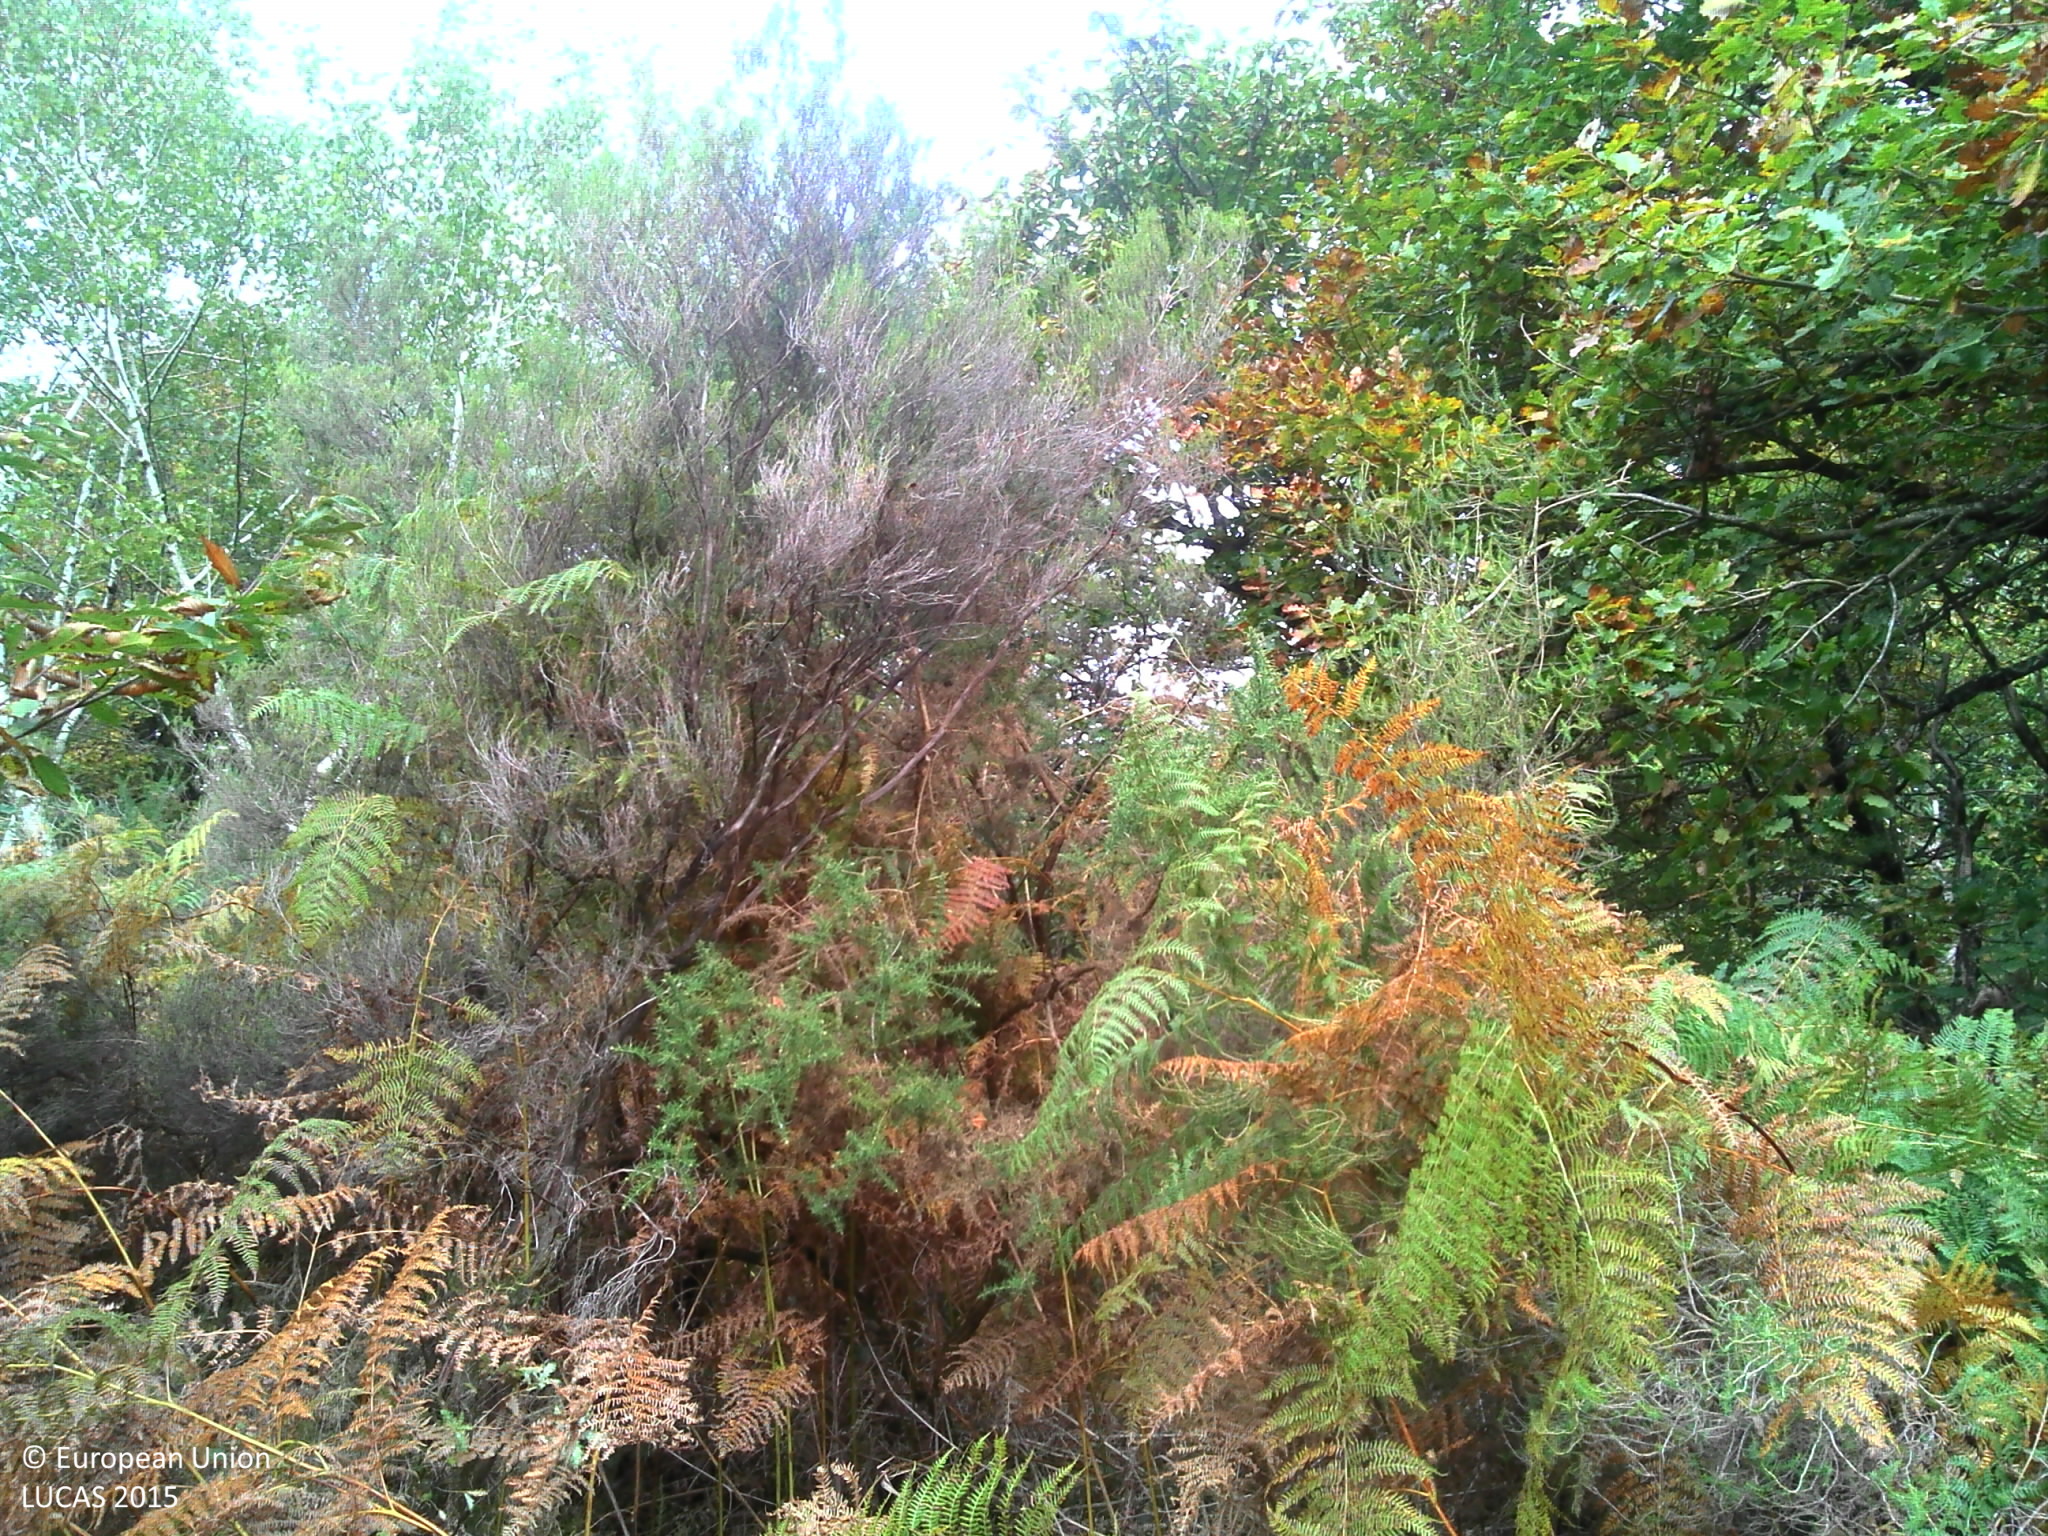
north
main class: Woodland
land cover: Broadleaved woodland
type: acidophilous oak and oak-birch forest
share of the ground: > 75 %
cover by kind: broadleaved forest trees 65 %, shrubs 20 %, herbaceous plants 10 %, lichens and mosses 5 %
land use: Community services
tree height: > 5 m
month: October
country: FR
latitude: 47.1601
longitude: 0.0966
